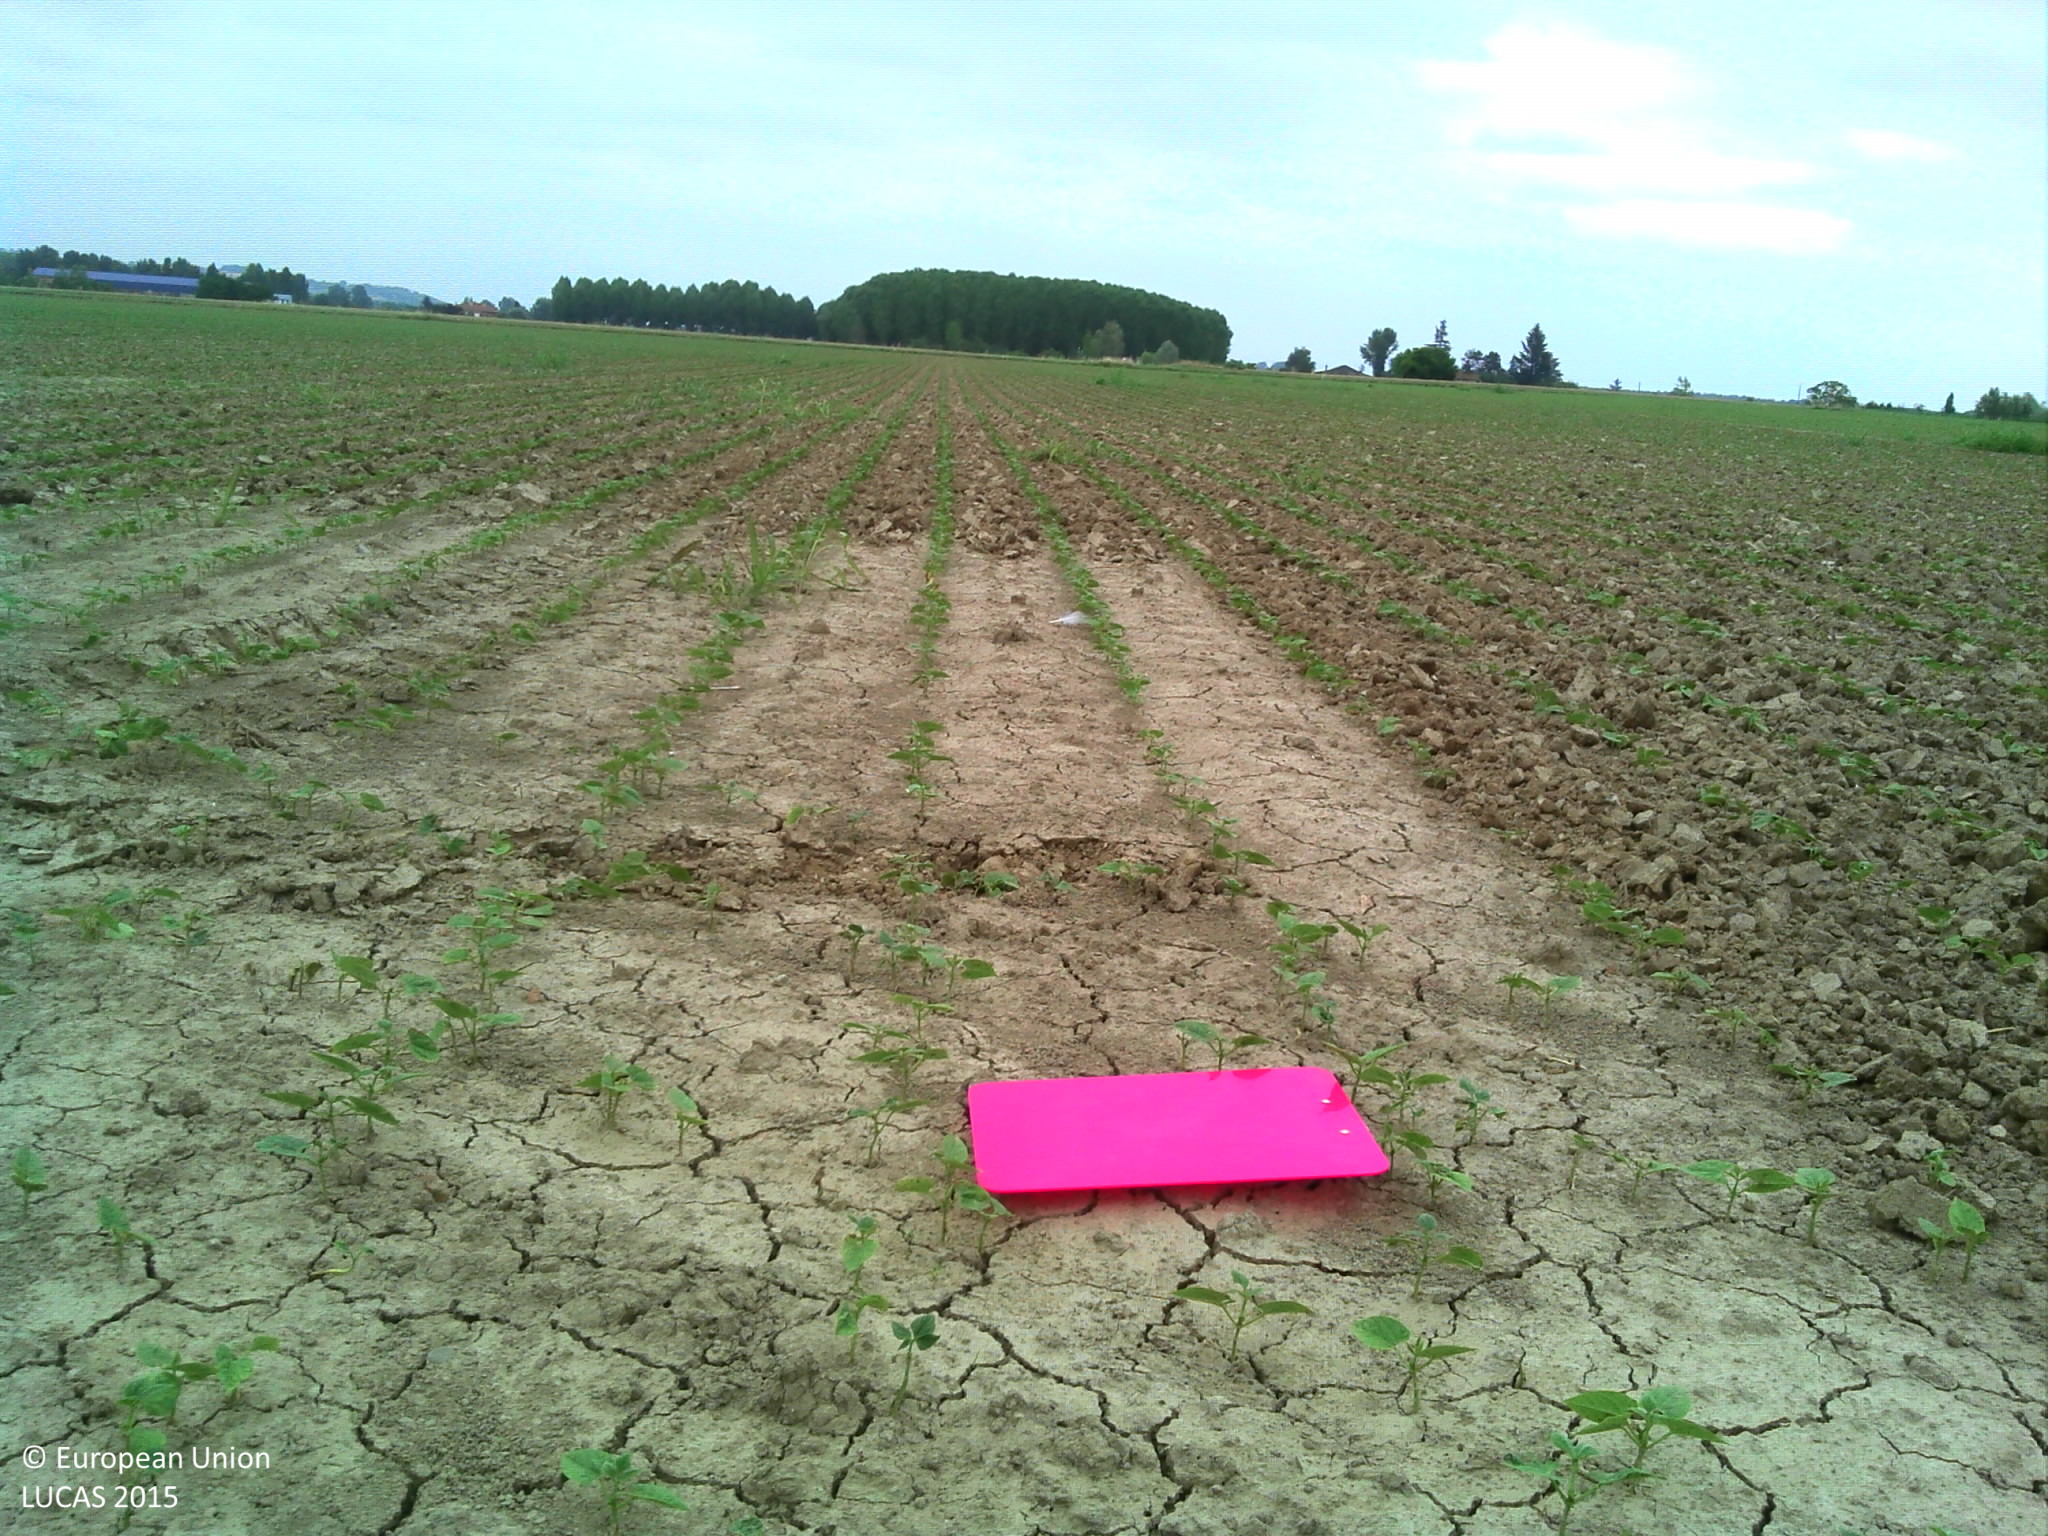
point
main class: Cropland
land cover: Other fresh vegetables
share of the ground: < 10 %
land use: Agriculture (excluding fallow land and kitchen gardens)
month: June
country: FR
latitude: 44.0966
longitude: 0.9160
